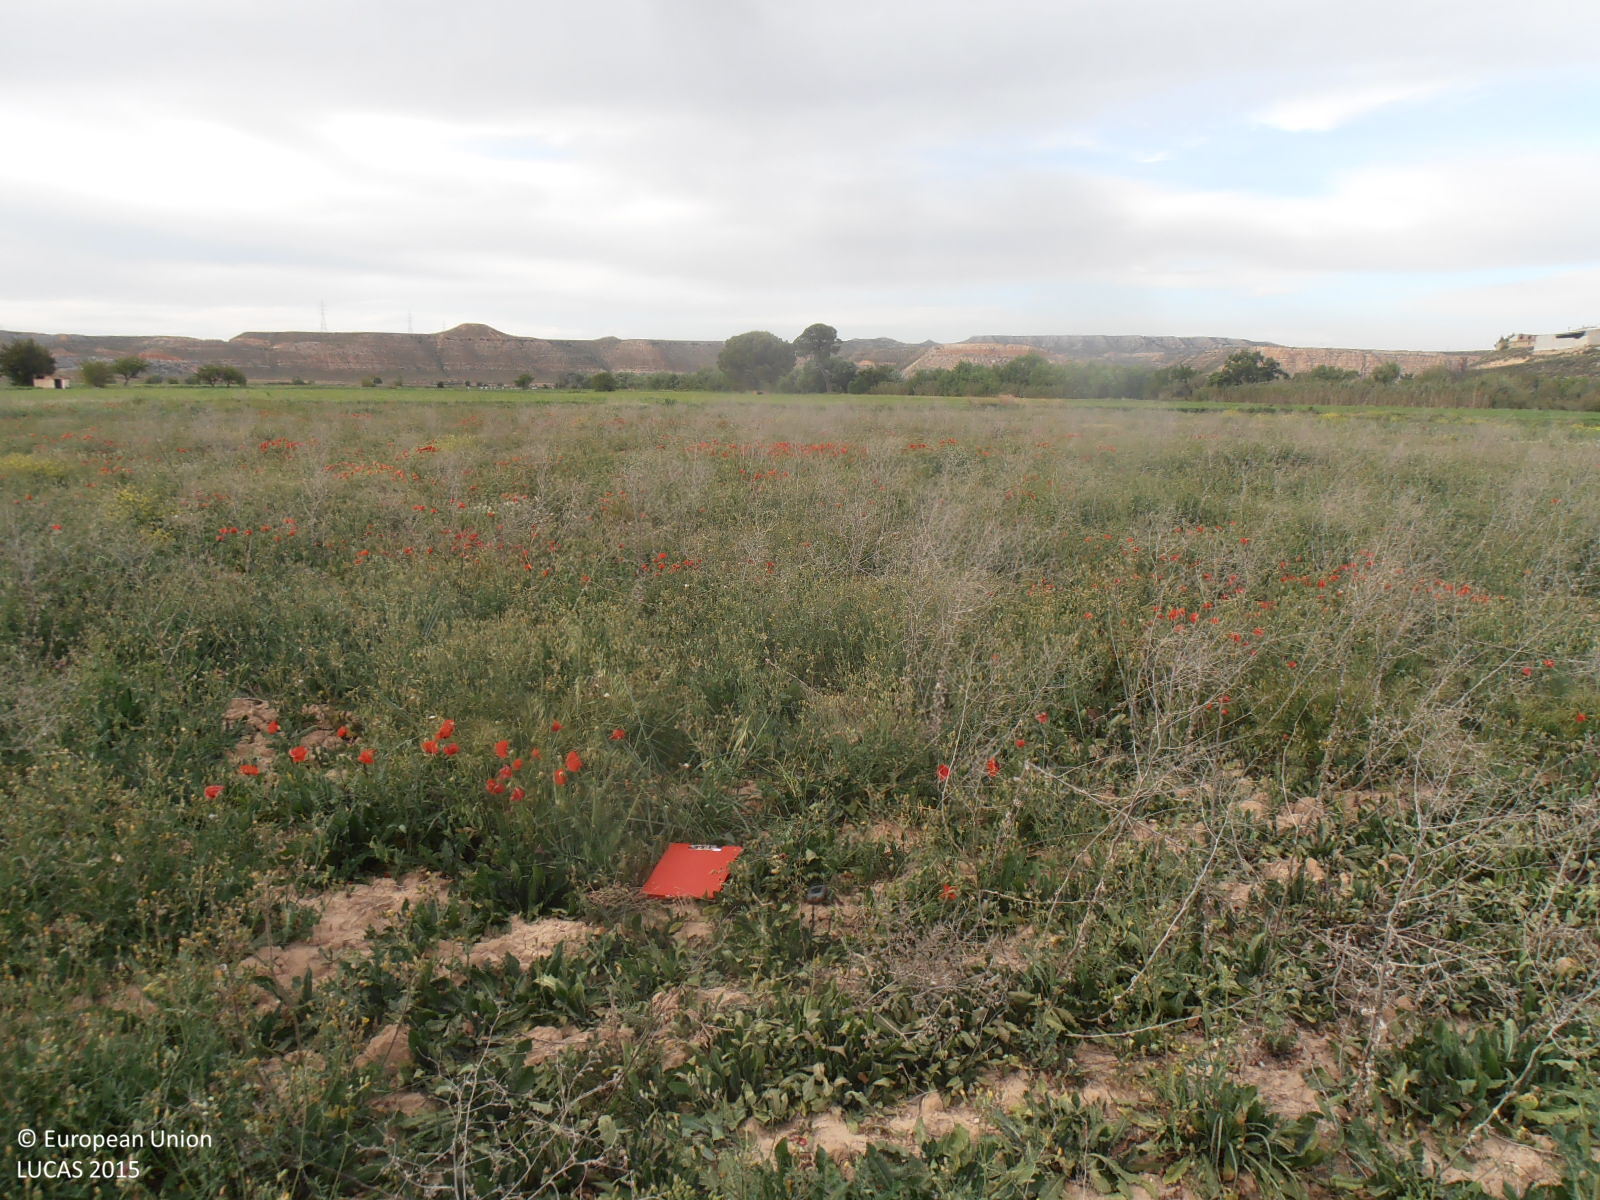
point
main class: Grassland
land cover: Spontaneously vegetated surfaces
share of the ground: > 75 %
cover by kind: herbaceous plants 100 %
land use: Fallow land
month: April
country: ES
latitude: 41.3371
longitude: -0.3757
